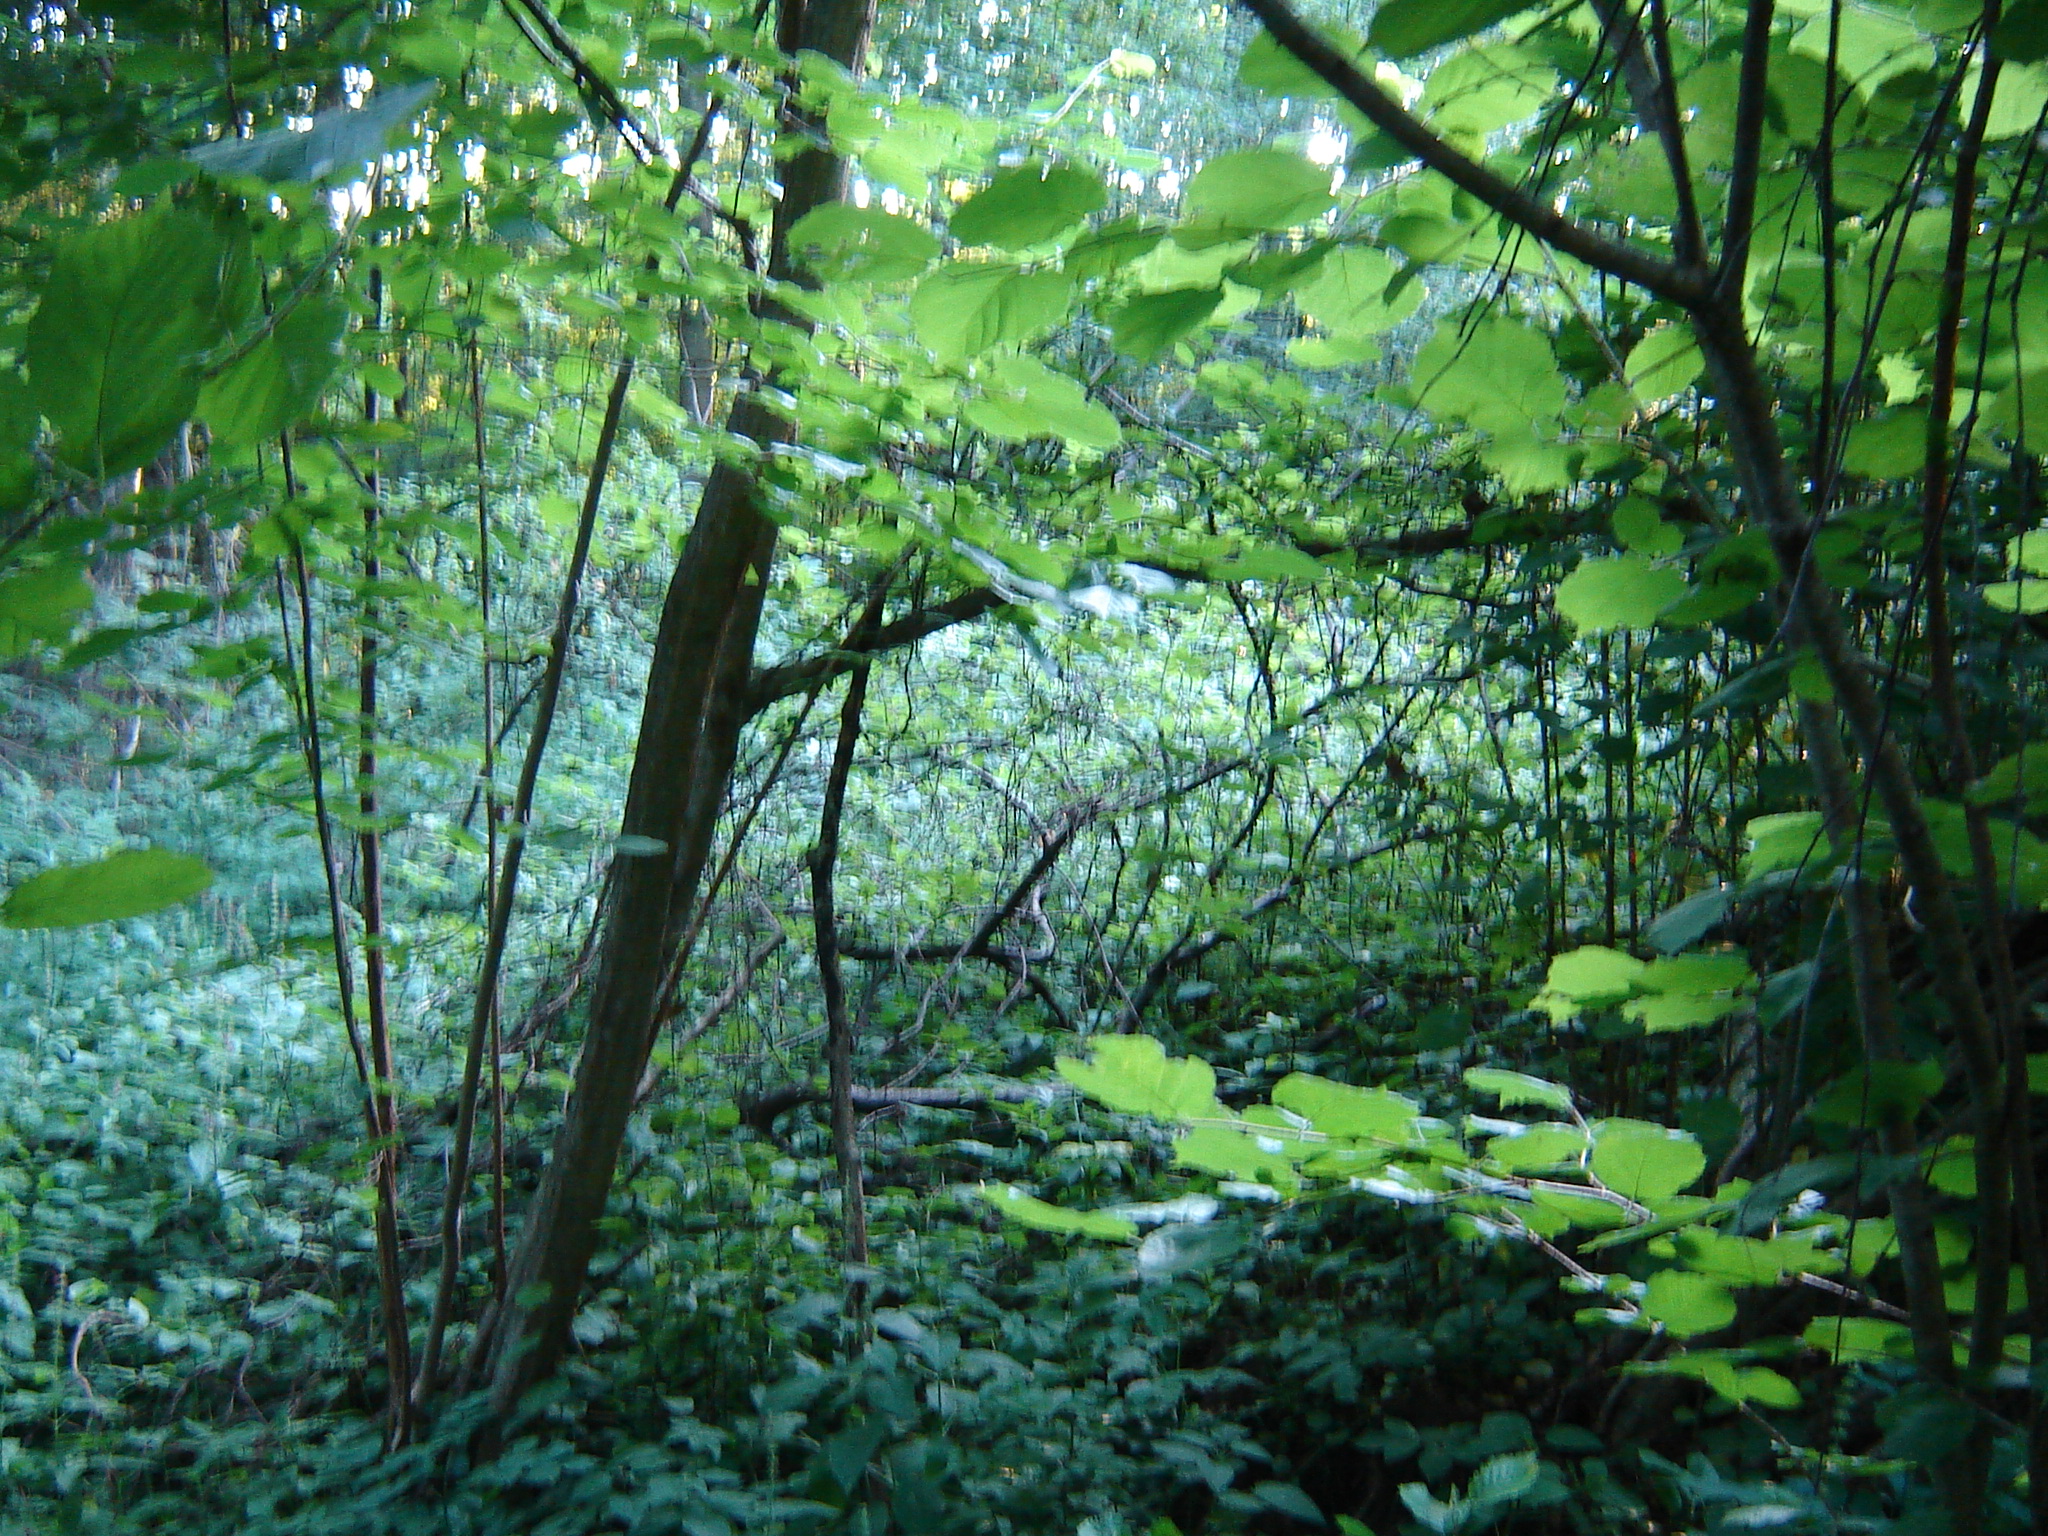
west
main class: Woodland
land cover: Broadleaved woodland
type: non-riverine alder, birch or aspen forest
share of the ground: > 75 %
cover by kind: broadleaved forest trees 100 %
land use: Forestry
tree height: > 5 m
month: July
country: LT
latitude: 55.3999
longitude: 25.5211
